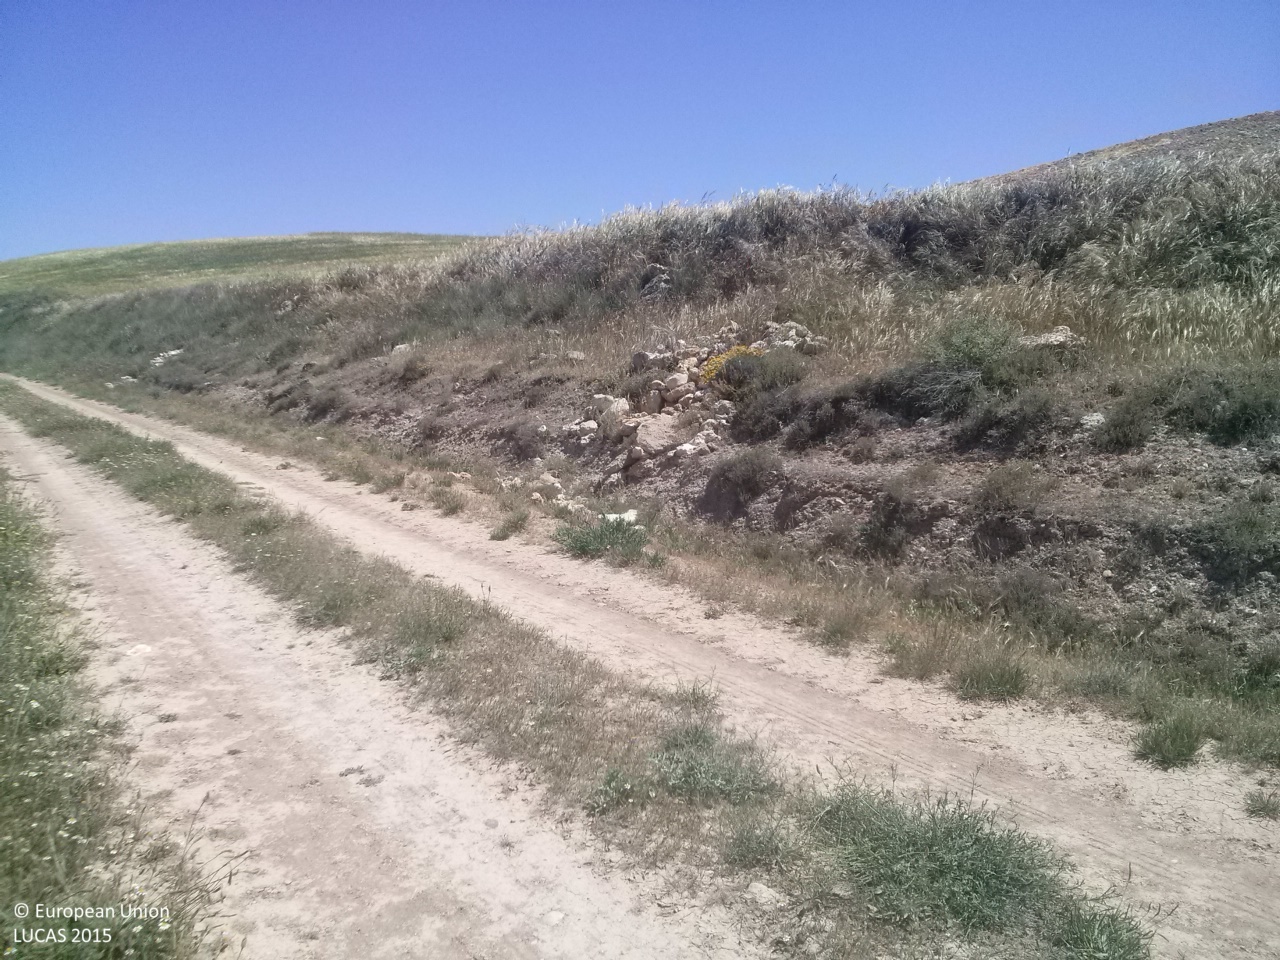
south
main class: Cropland
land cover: Barley
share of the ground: > 75 %
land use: Agriculture (excluding fallow land and kitchen gardens)
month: May
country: ES
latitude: 40.2929
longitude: -2.5983
